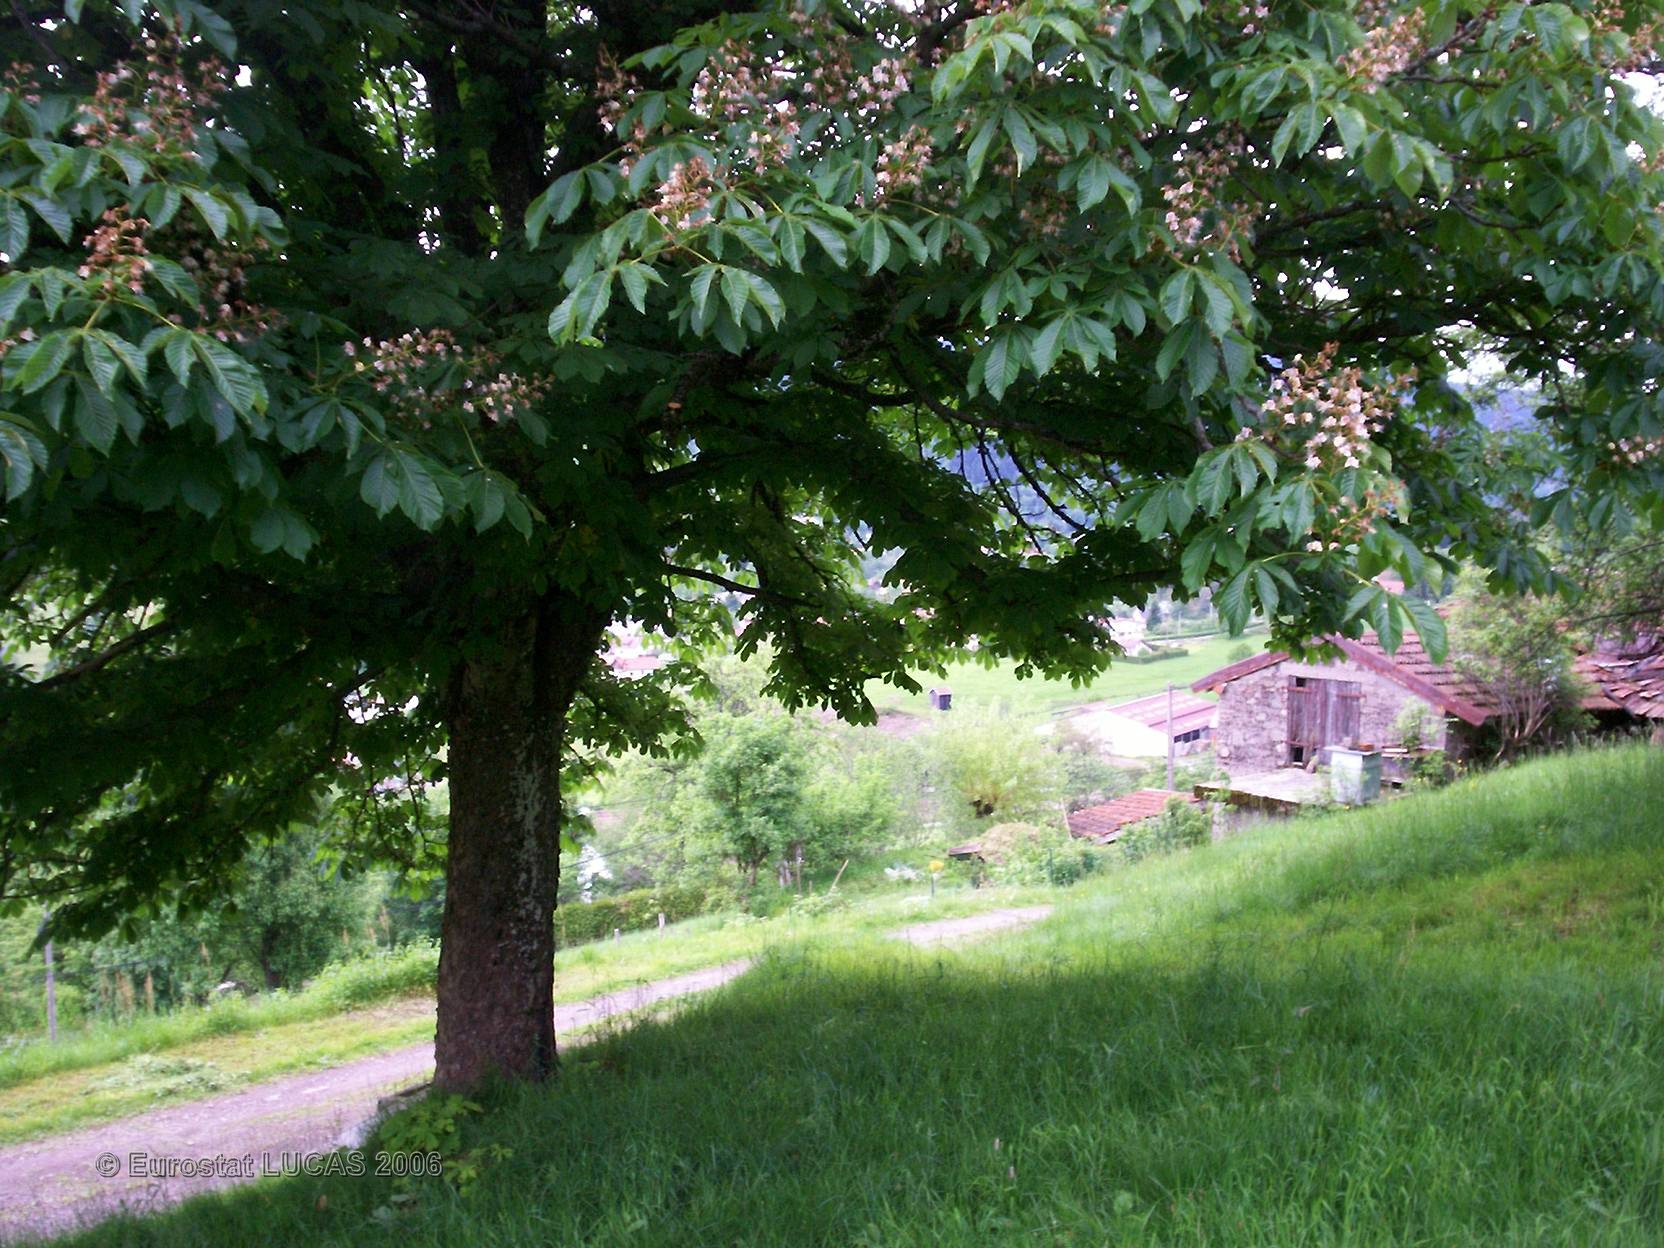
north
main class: Grassland
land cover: Grassland with sparse tree/shrub cover
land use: Agriculture (excluding fallow land and kitchen gardens)
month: June
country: FR
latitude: 47.8883
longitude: 6.7781
